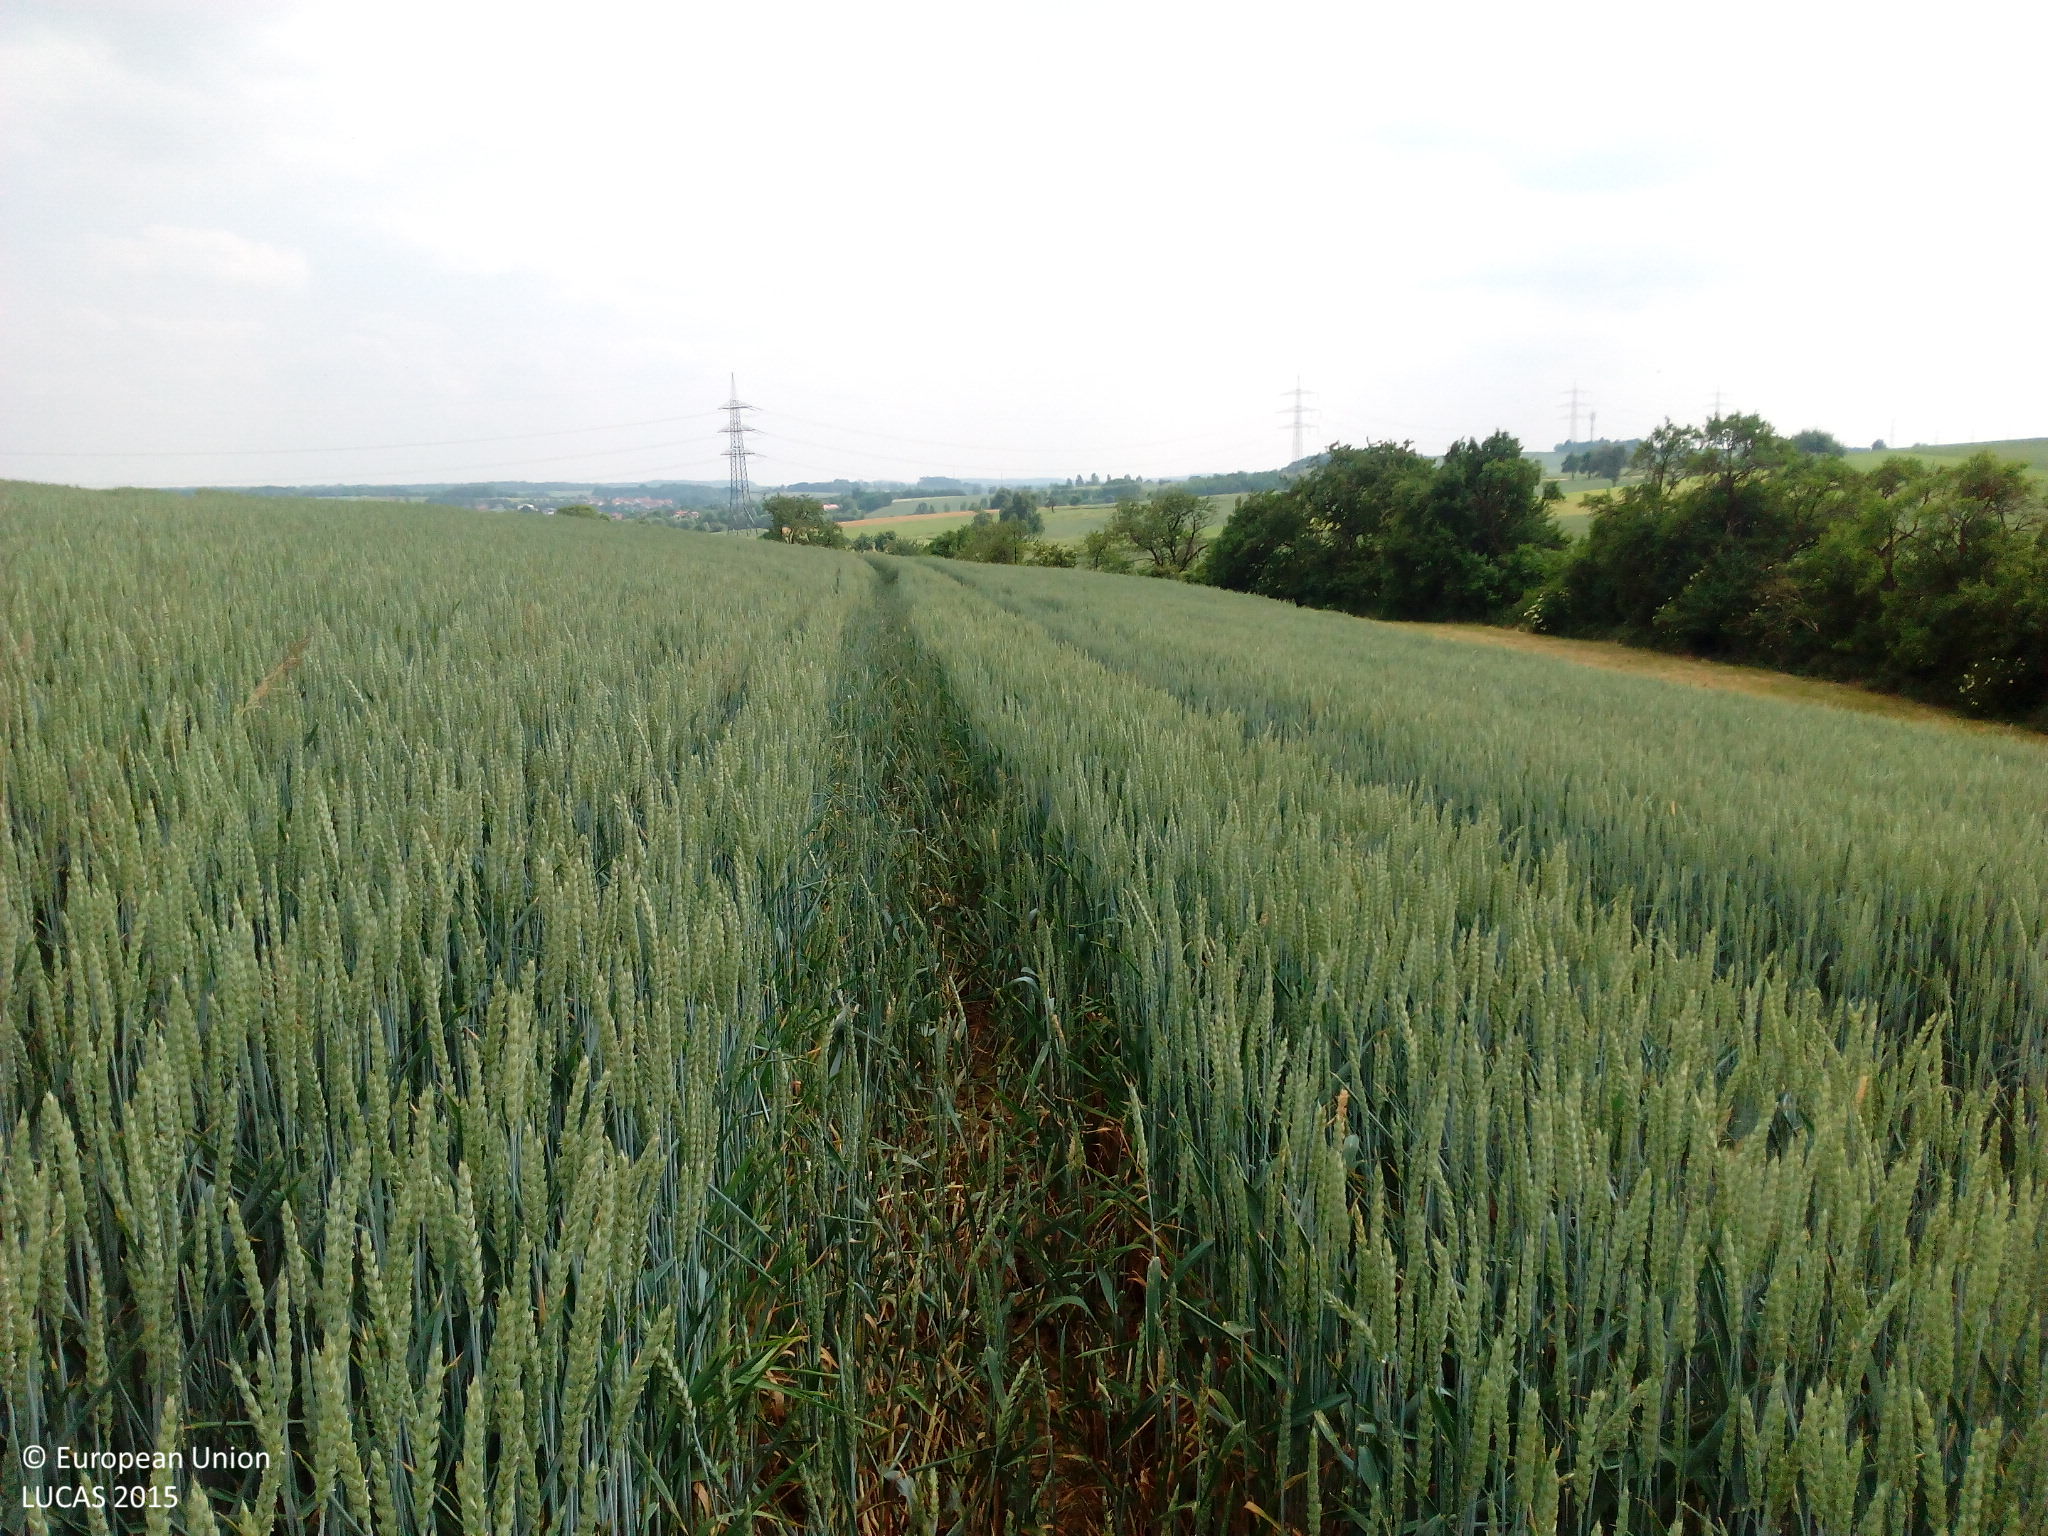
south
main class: Cropland
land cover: Common wheat
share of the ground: > 75 %
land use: Agriculture (excluding fallow land and kitchen gardens)
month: June
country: DE
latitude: 49.4265
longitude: 9.2696
